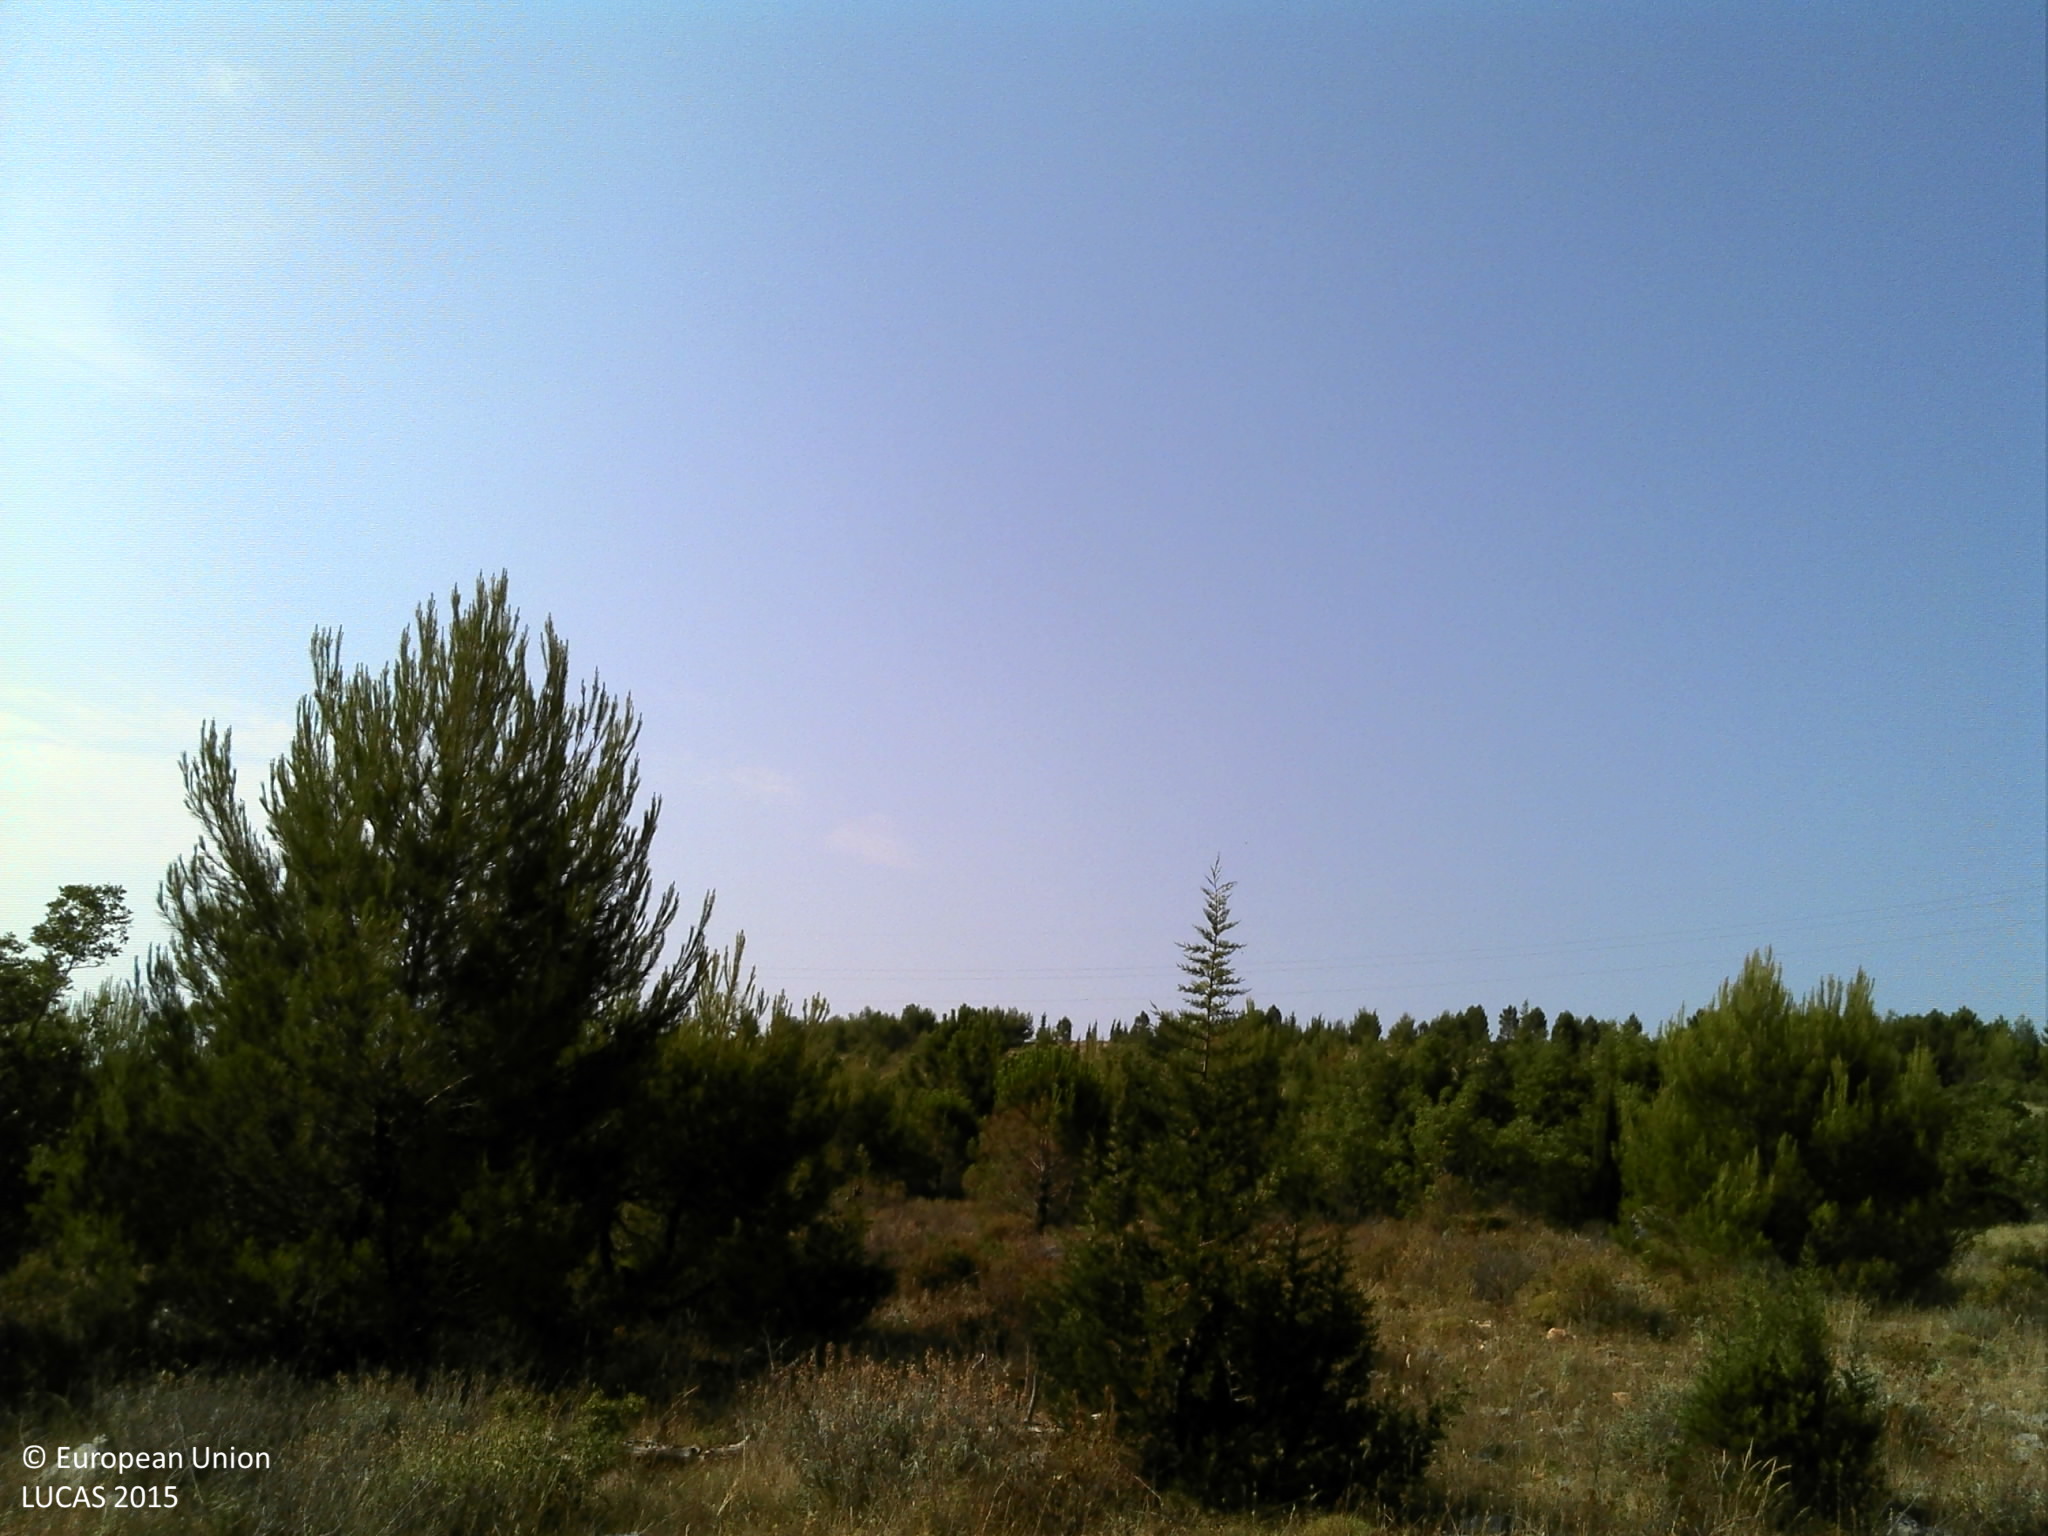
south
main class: Woodland
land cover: Pine dominated coniferous woodland
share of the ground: 10 - 25 %
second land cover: Grassland without tree/shrub cover
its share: > 75 %
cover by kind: consolidated bare surface 35 %, herbaceous plants 30 %, coniferous forest trees 25 %, shrubs 10 %
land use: Agriculture (excluding fallow land and kitchen gardens)
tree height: > 5 m
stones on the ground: 25 - 50 %
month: July
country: HR
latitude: 42.8239
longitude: 17.8065
